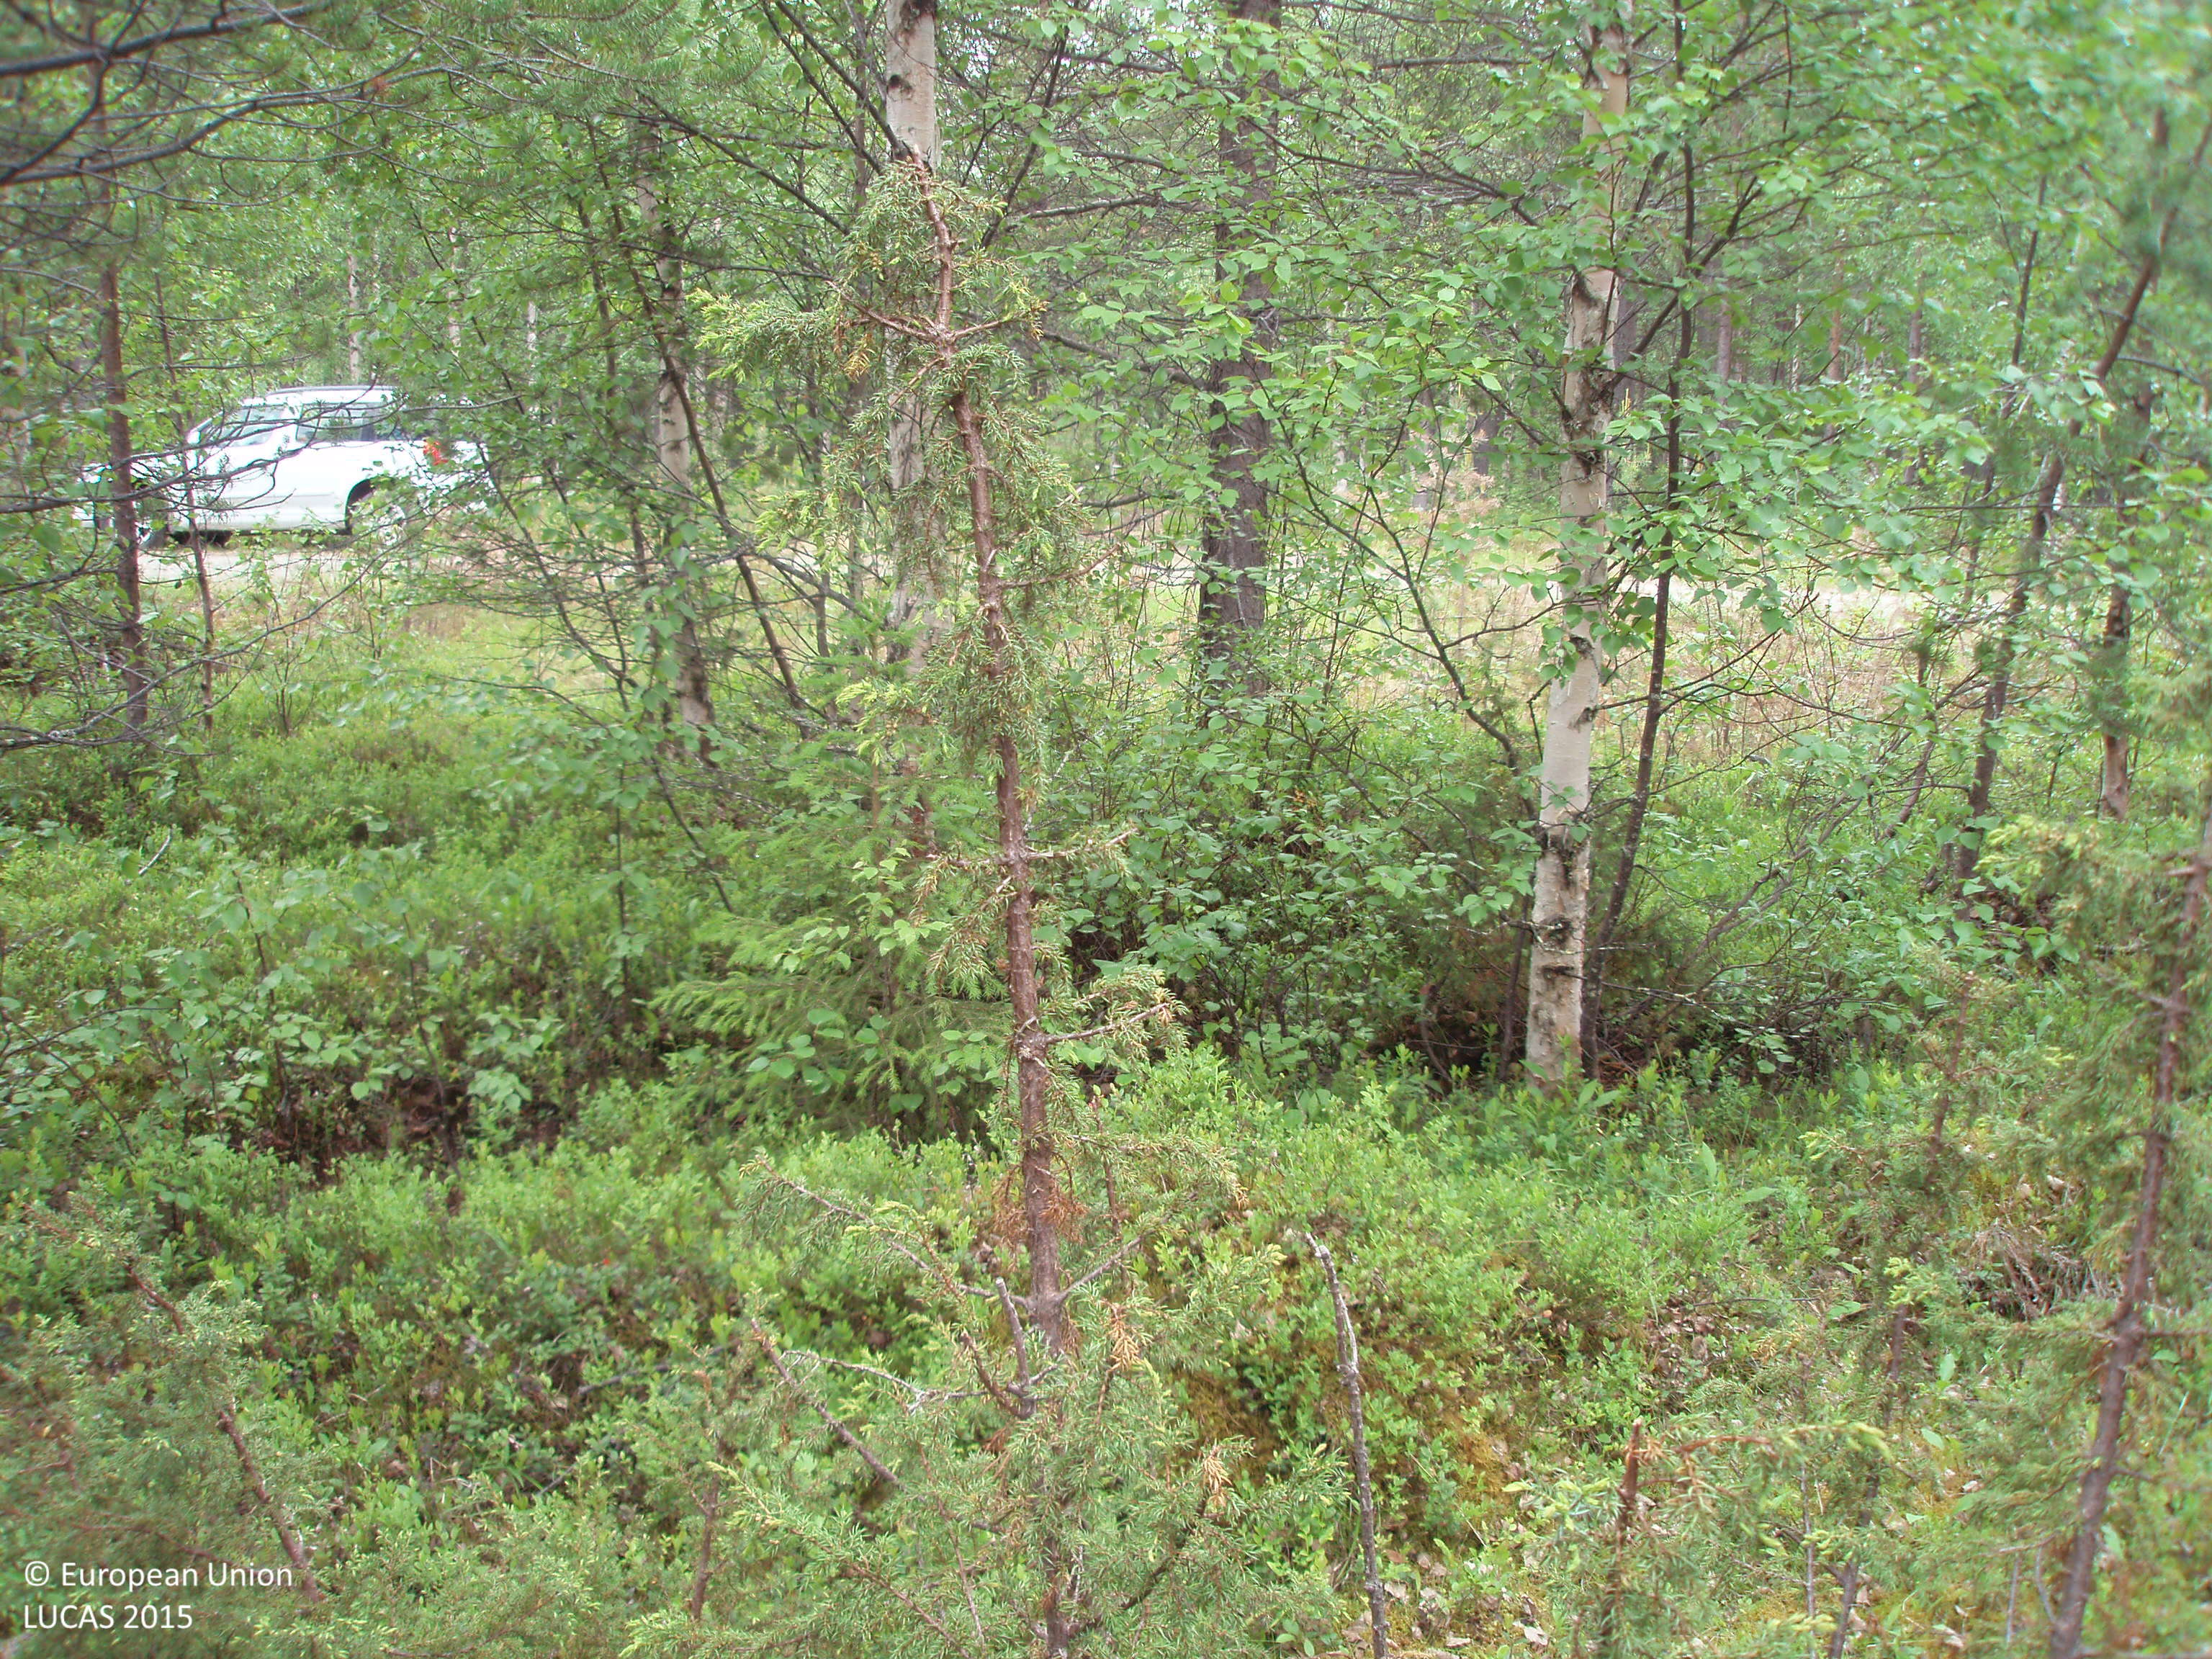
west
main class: Woodland
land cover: Pine dominated mixed woodland
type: boreal forest
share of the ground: > 75 %
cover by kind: coniferous forest trees 50 %, broadleaved forest trees 30 %, shrubs 20 %
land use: Forestry
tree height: > 5 m
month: July
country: FI
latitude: 67.4506
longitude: 27.4116
